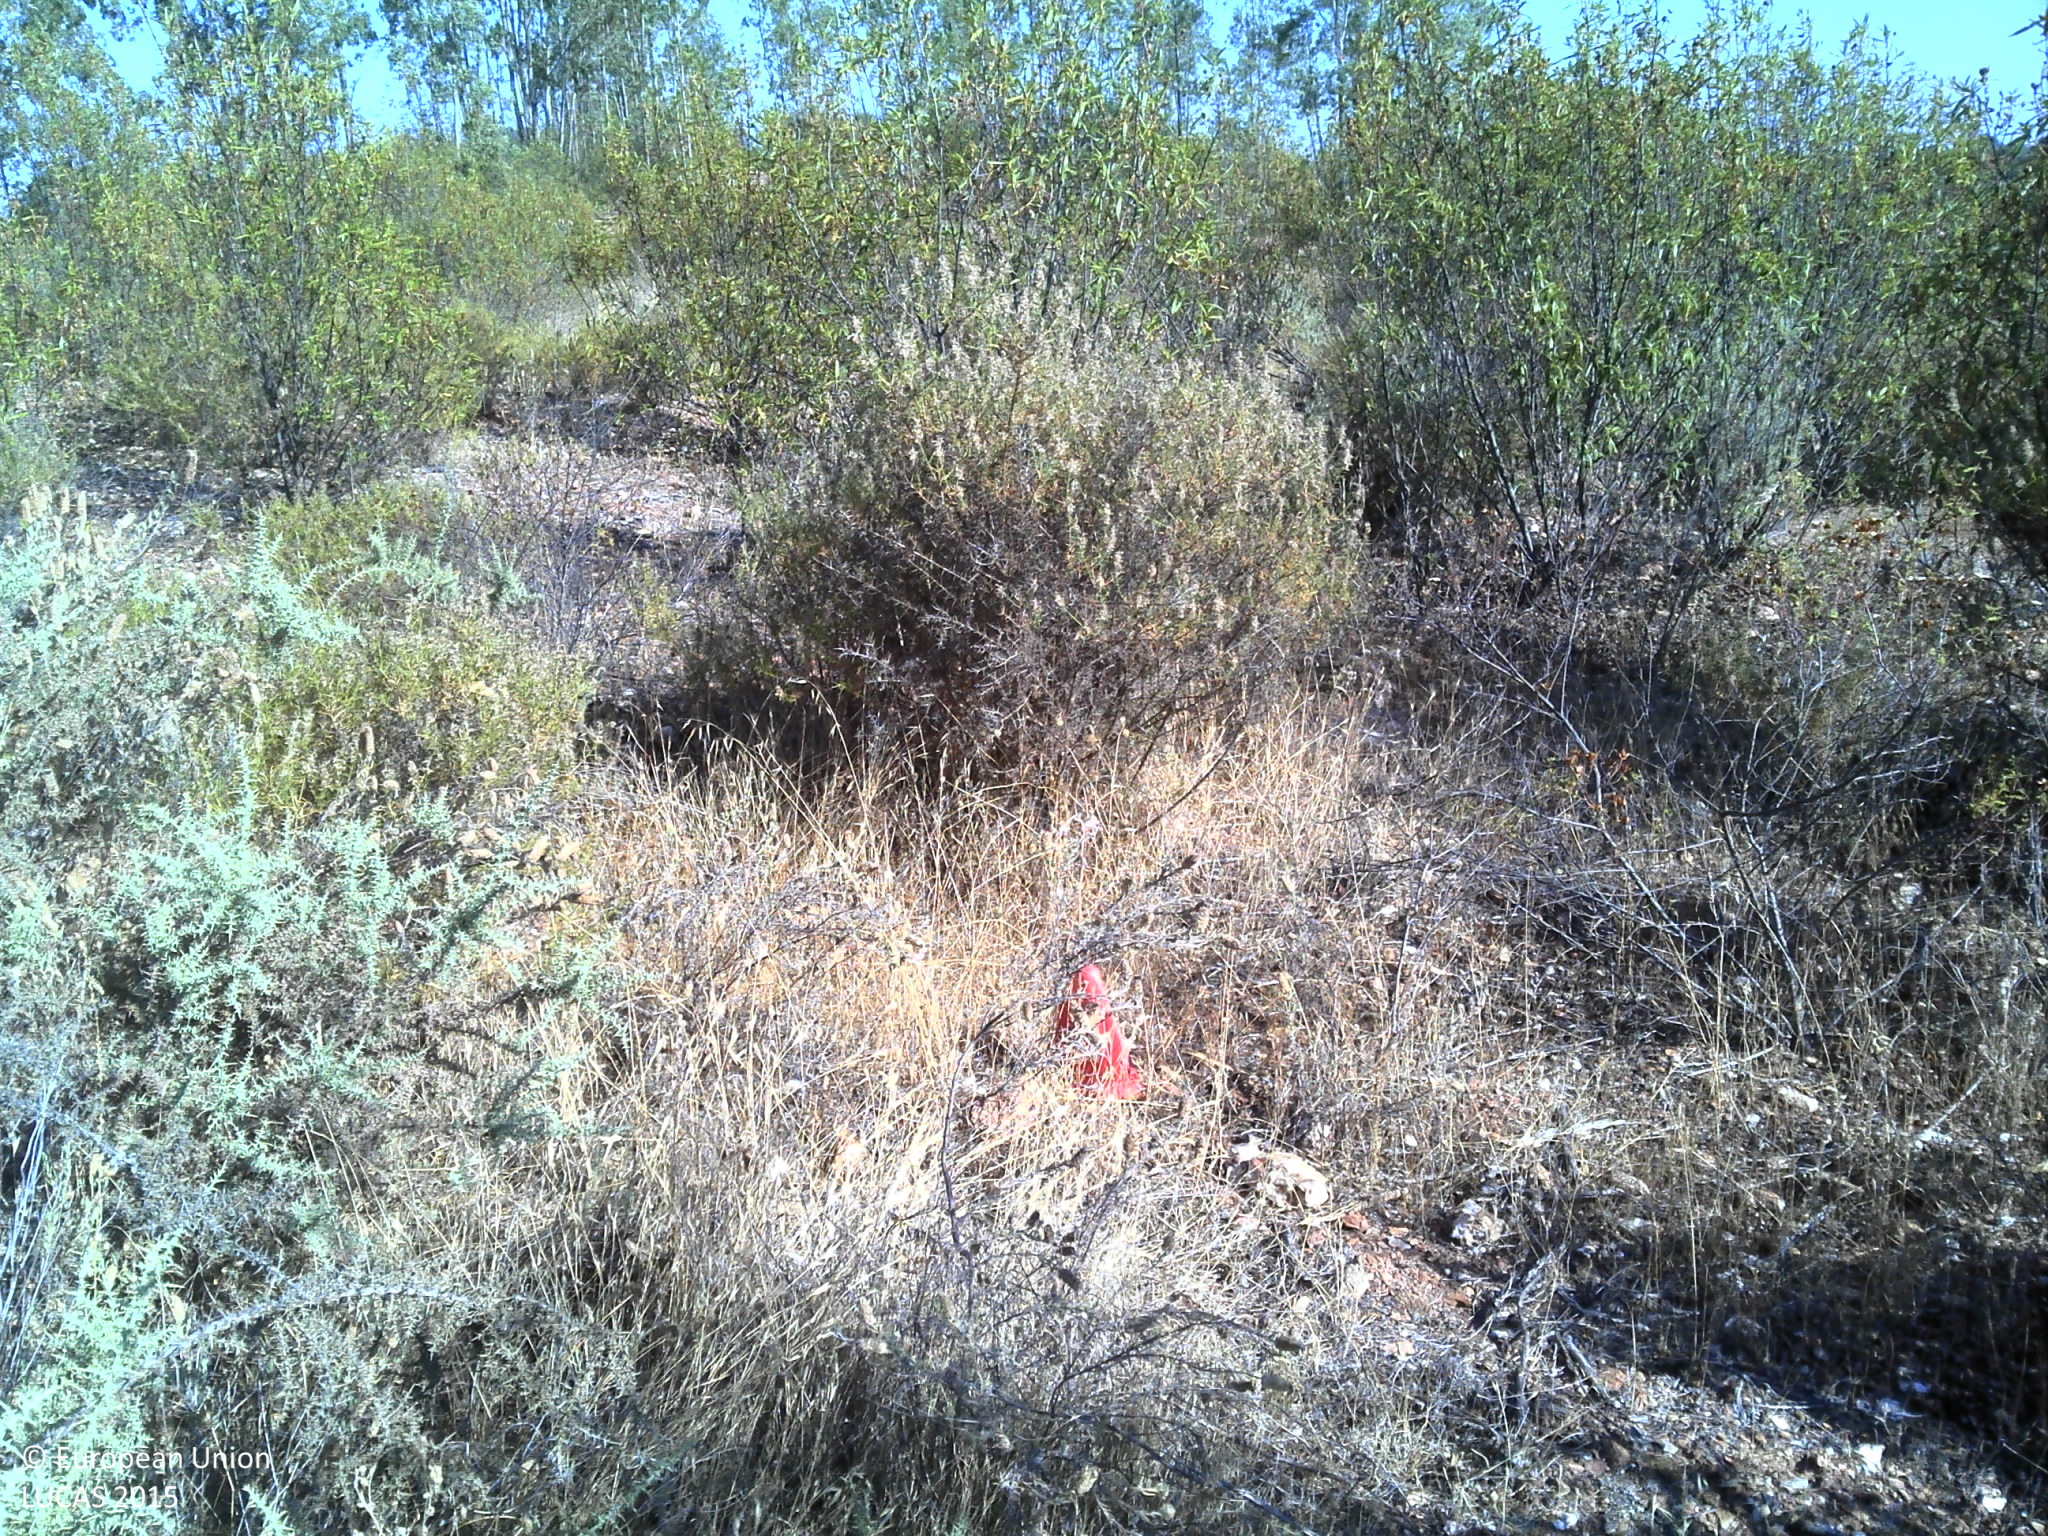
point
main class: Shrubland
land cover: Shrubland with sparse tree cover
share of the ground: > 75 %
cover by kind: shrubs 90 %, broadleaved forest trees 5 %, unconsolidated bare surface 5 %
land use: Abandoned areas
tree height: < 5 m
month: June
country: PT
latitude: 37.9068
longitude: -7.2892
